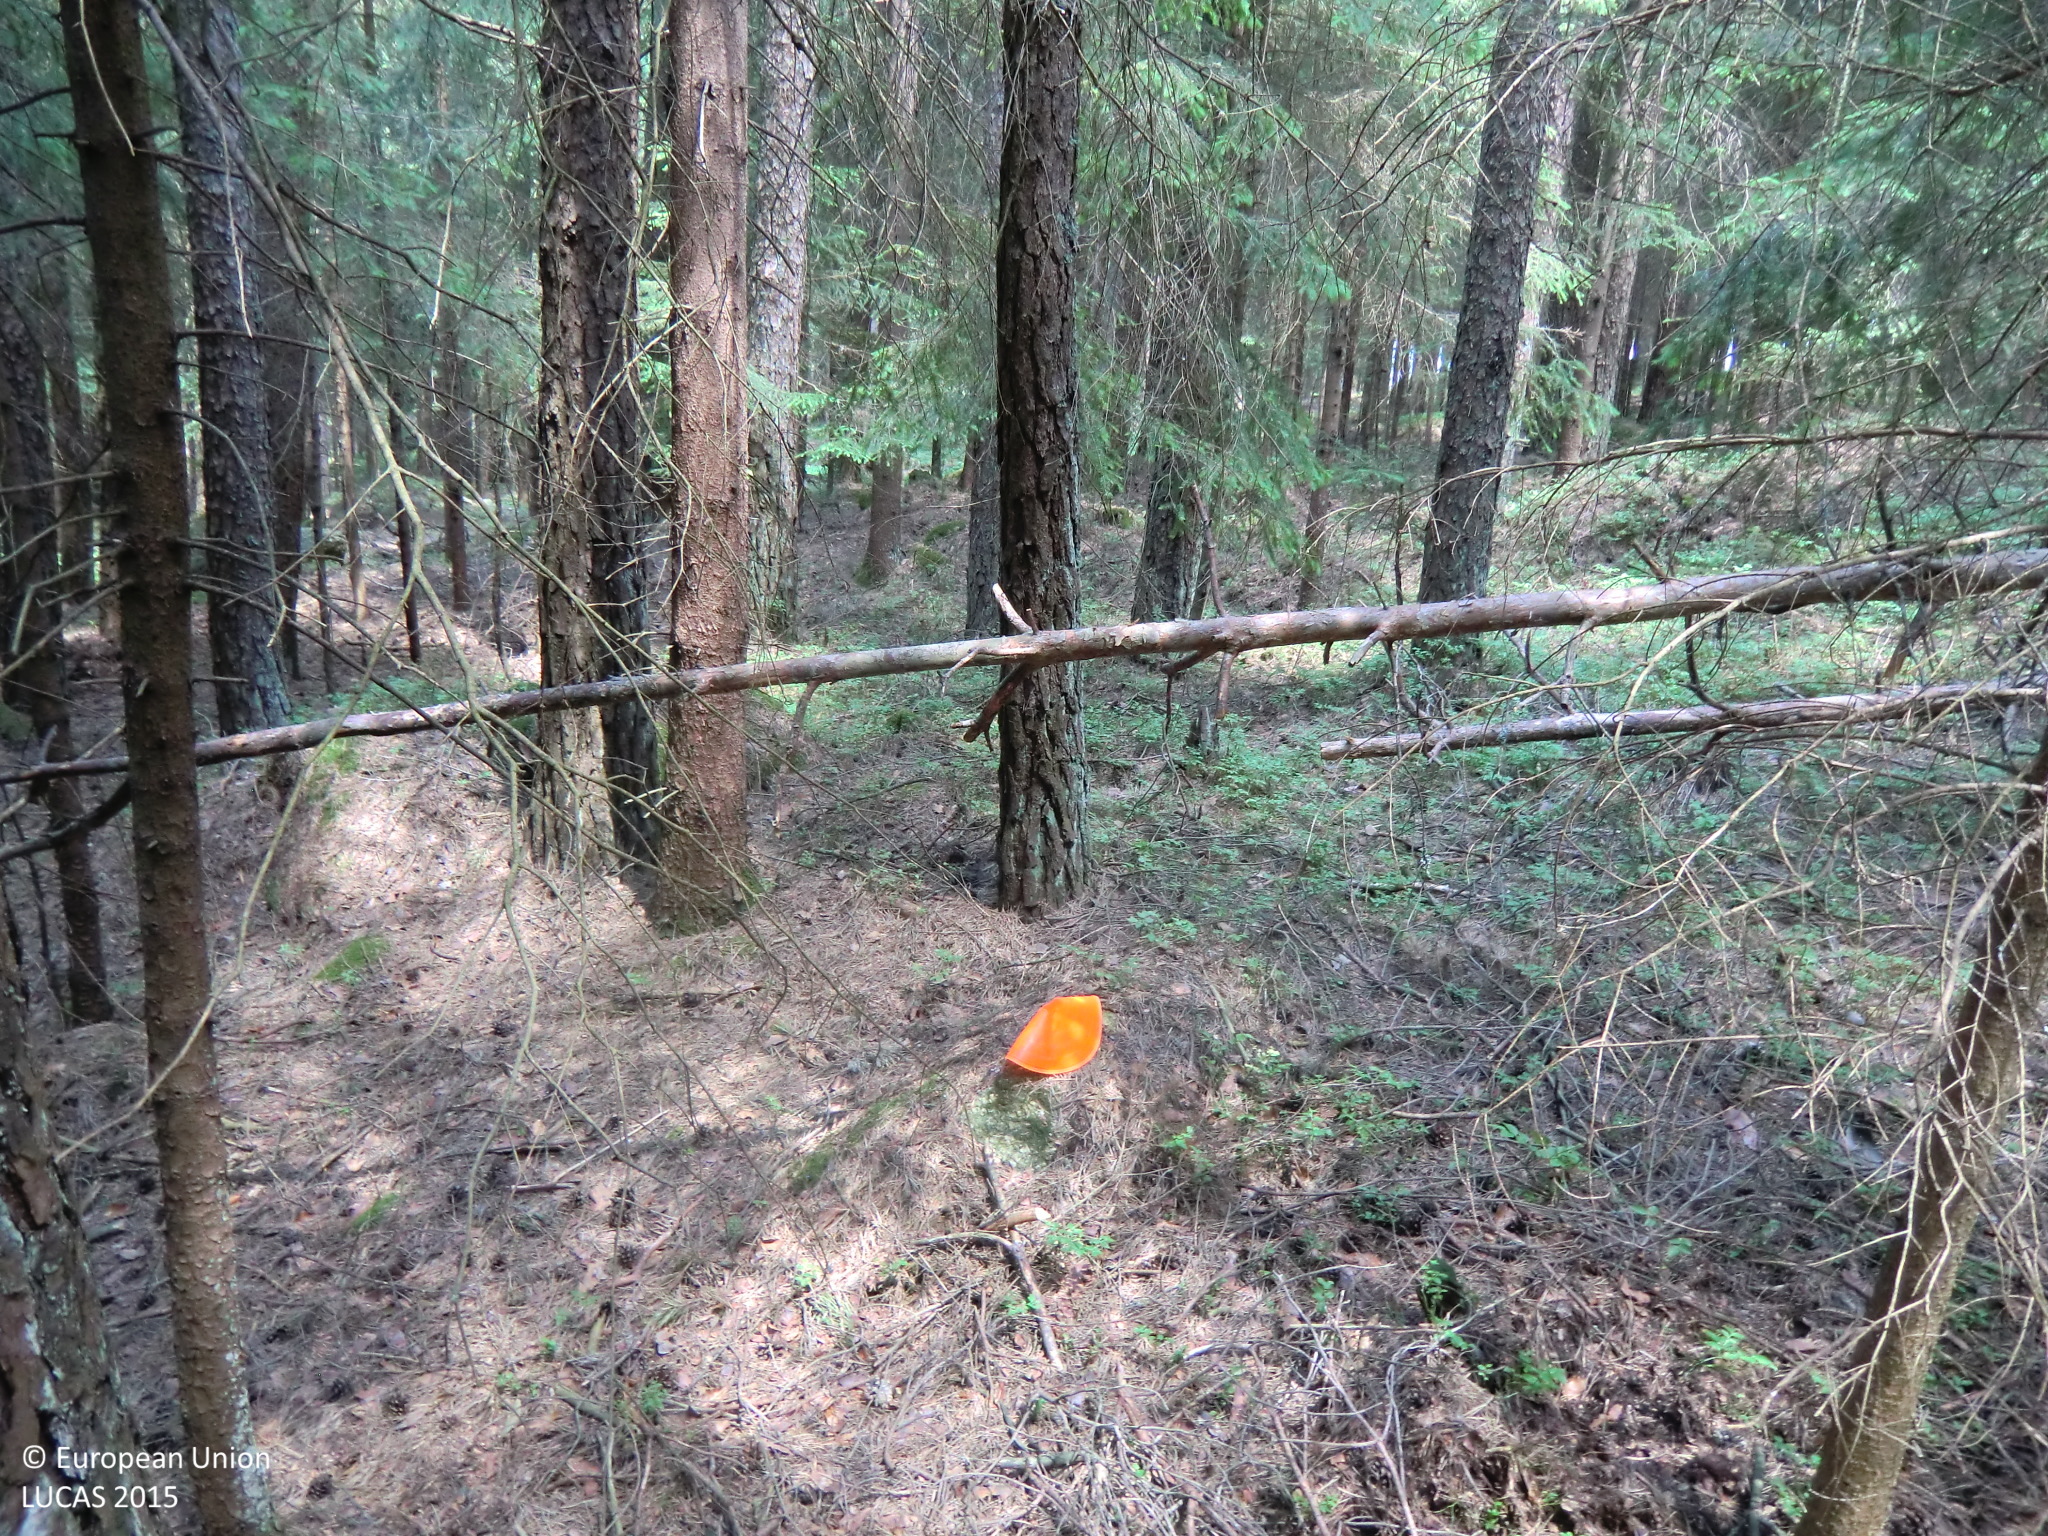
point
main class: Woodland
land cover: Pine dominated coniferous woodland
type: hemiboreal forest and nemoral coniferous forest and mixed broadleaved-coniferous forest
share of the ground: > 75 %
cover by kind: coniferous forest trees 95 %, unconsolidated bare surface 5 %
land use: Forestry
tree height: > 5 m
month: June
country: AT
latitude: 48.6589
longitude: 14.8210
